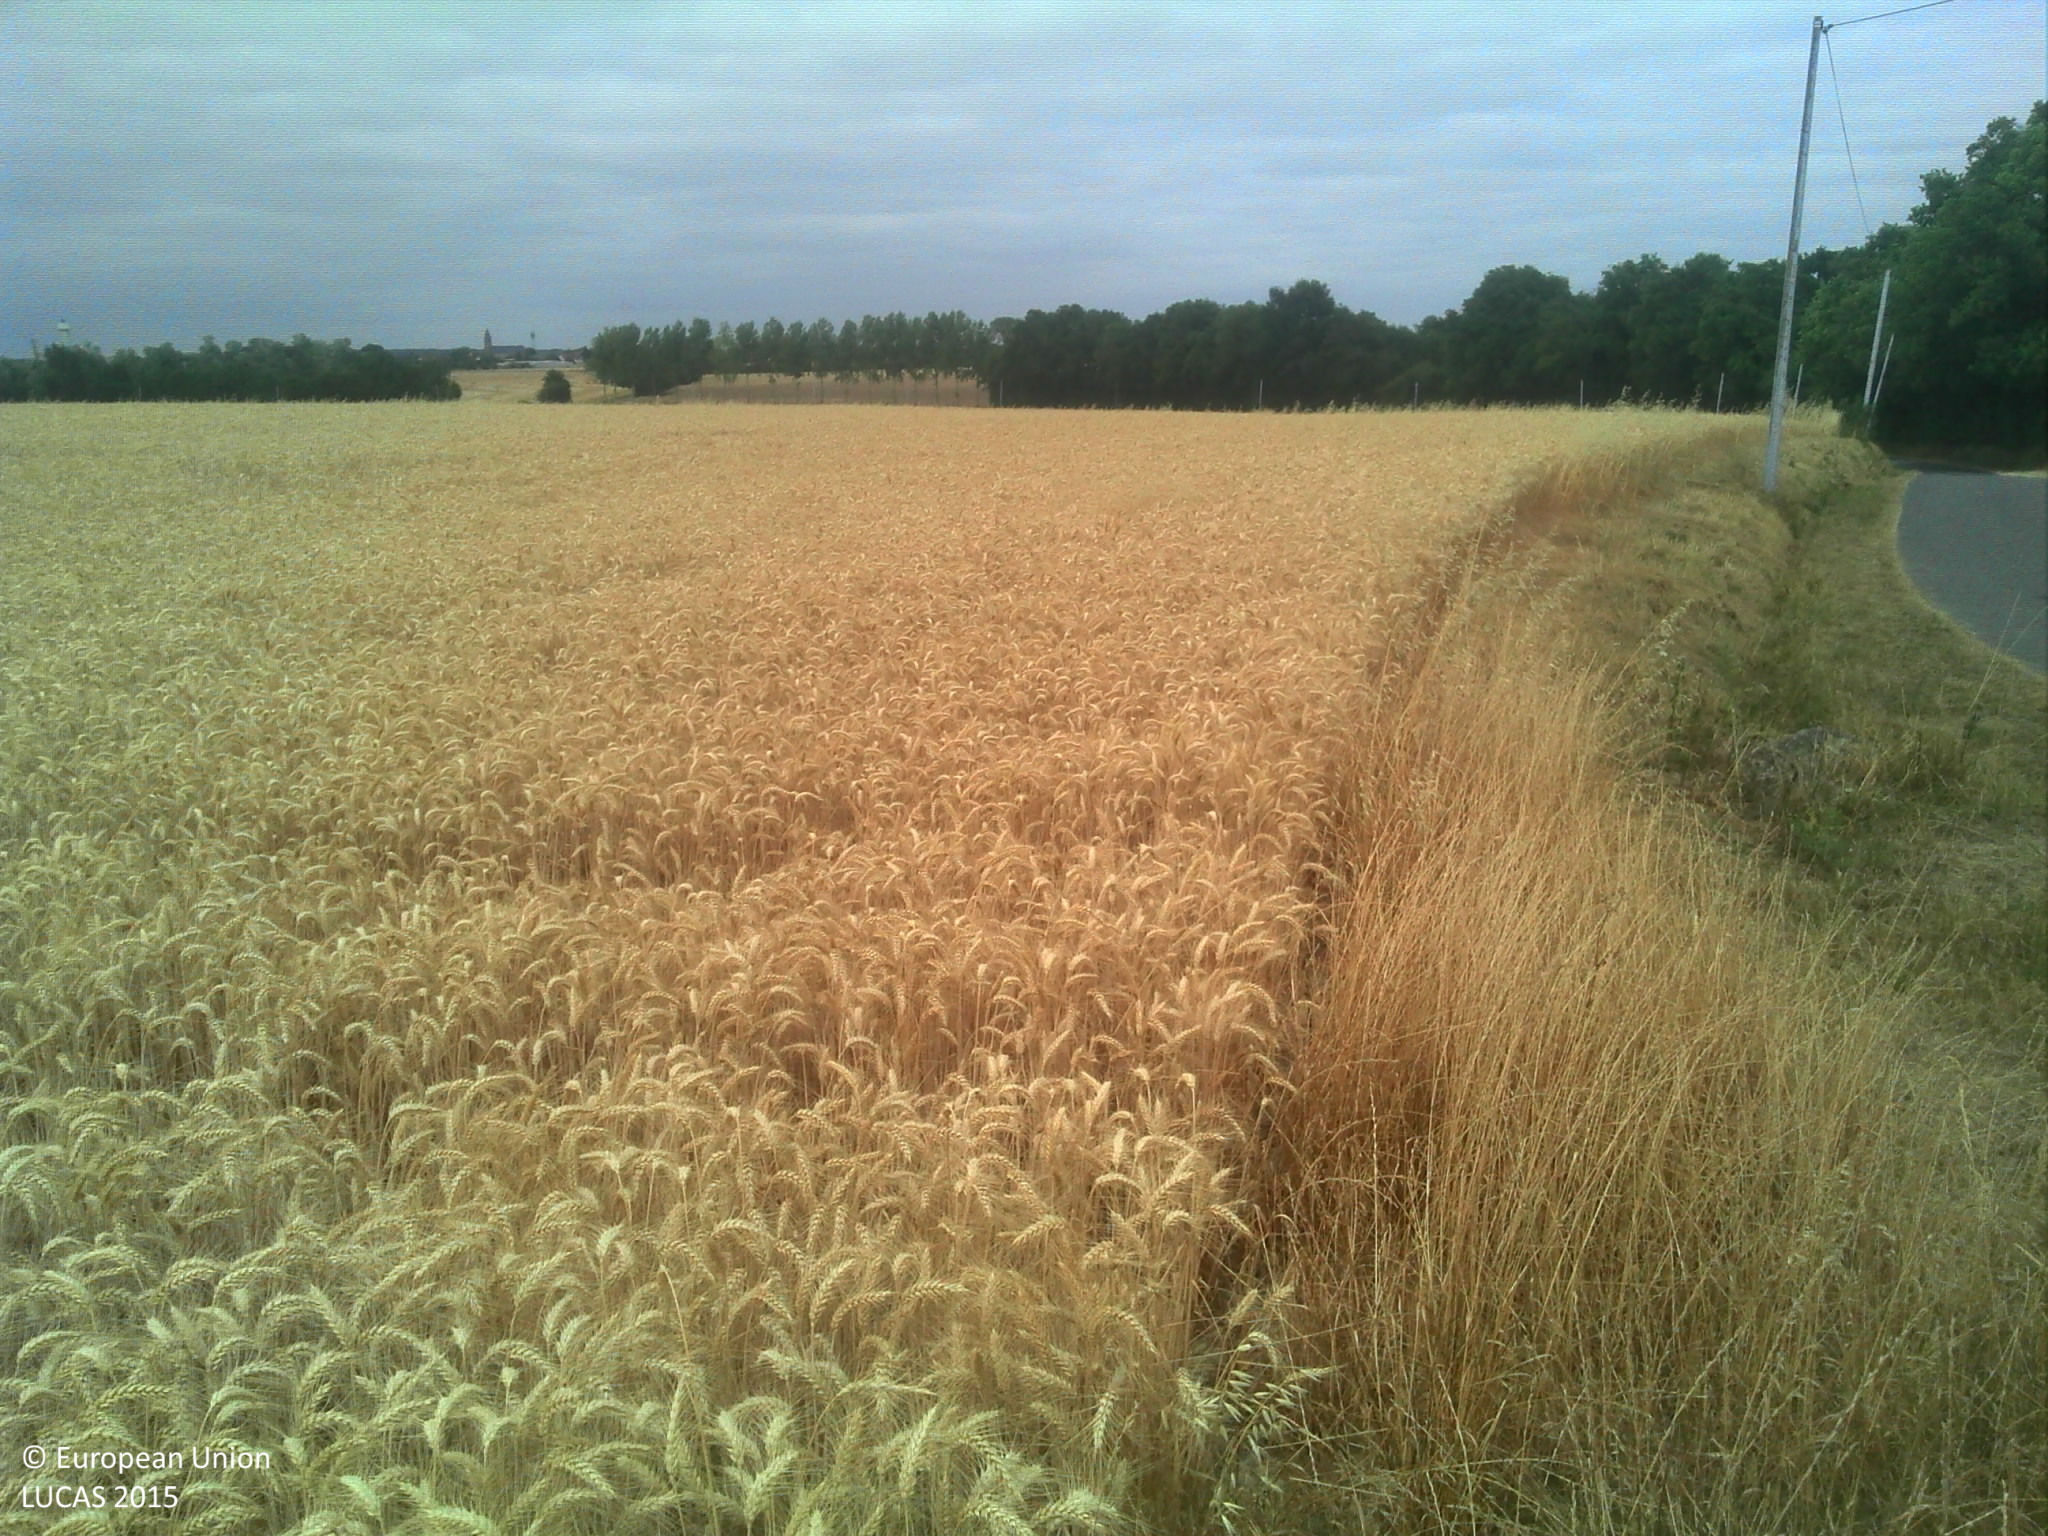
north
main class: Cropland
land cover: Common wheat
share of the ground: > 75 %
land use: Agriculture (excluding fallow land and kitchen gardens)
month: July
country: FR
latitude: 47.8850
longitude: 0.9271
